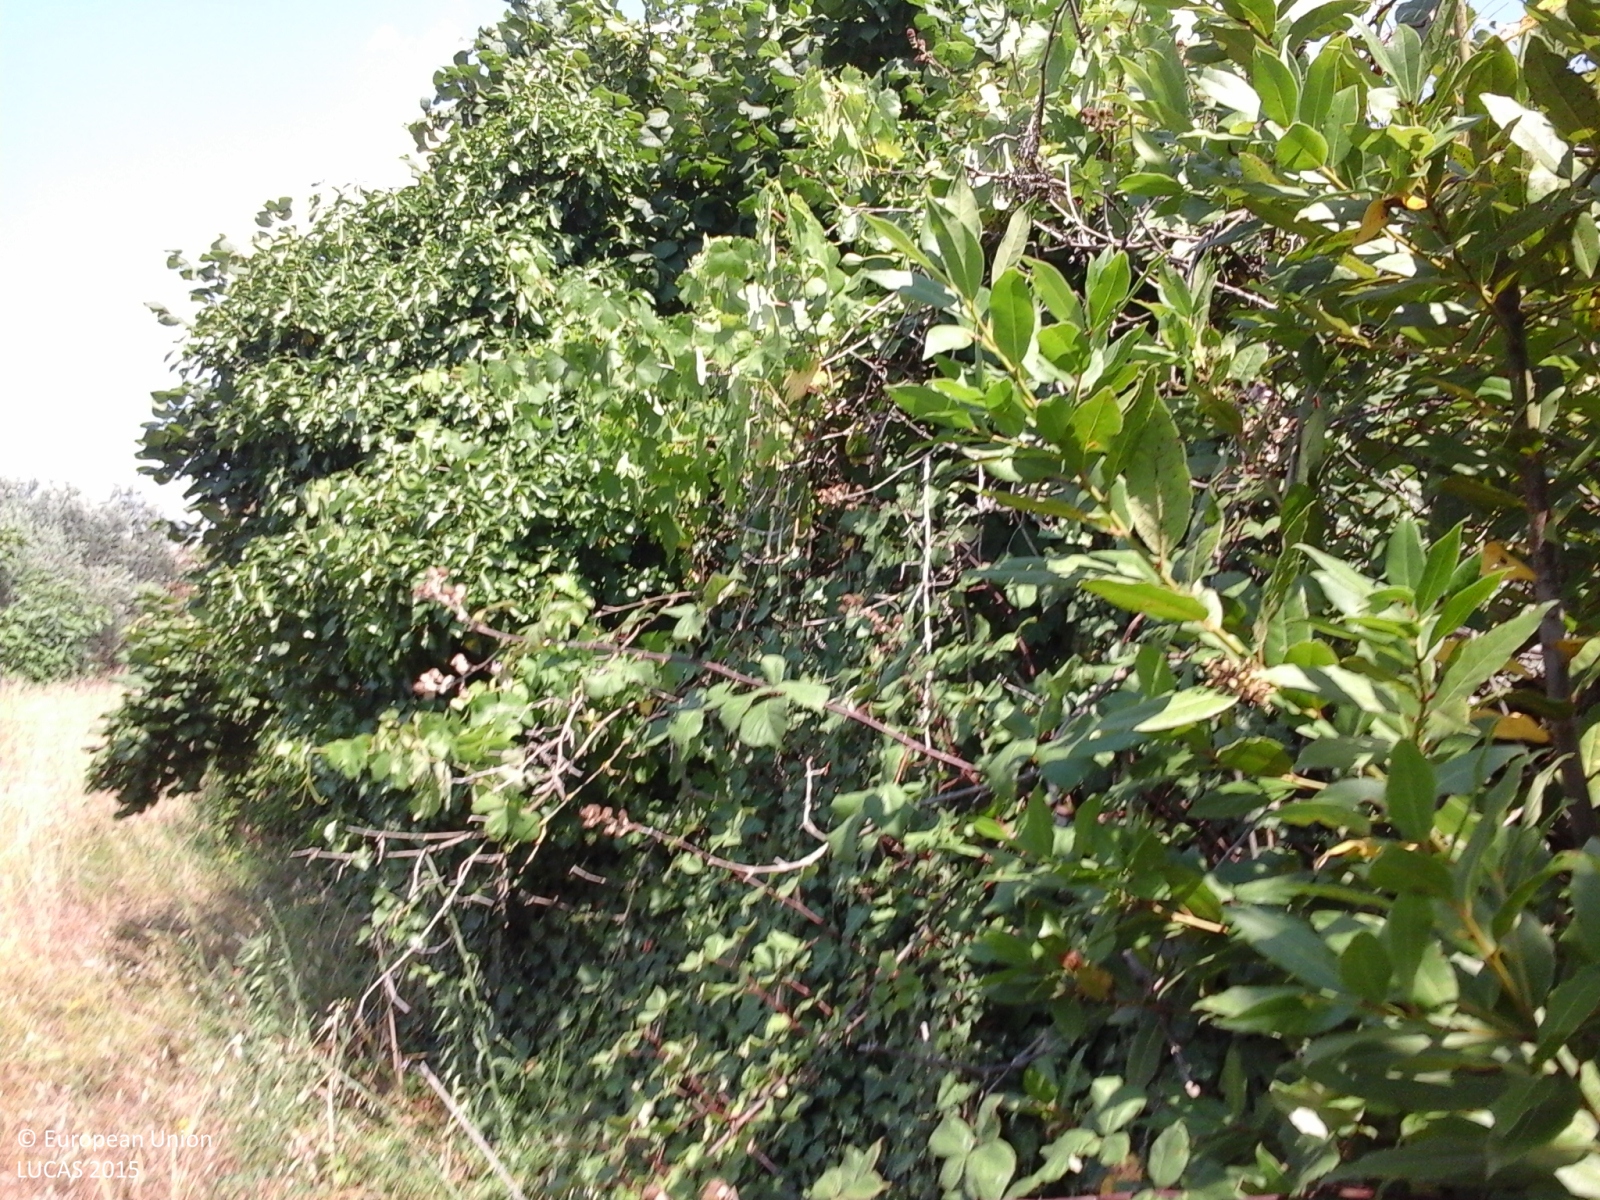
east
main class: Cropland
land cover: Olive groves
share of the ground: 25 - 50 %
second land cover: Grassland without tree/shrub cover
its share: > 75 %
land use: Agriculture (excluding fallow land and kitchen gardens)
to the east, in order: Grass margins; Managed hedges; Fences; Olive groves; Shrubland without tree cover; Grassland without tree/shrub cover; Tracks; Shrubland without tree cover; Cherry fruit; Olive groves; Shrubland without tree cover; Grassland without tree/shrub cover; Fences; Paved roads, cycling and walking lanes; Electric lines; Shrubland without tree cover; Olive groves; Fences; Tracks; Olive groves; Vineyards
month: July
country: IT
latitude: 41.8395
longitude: 12.7475
